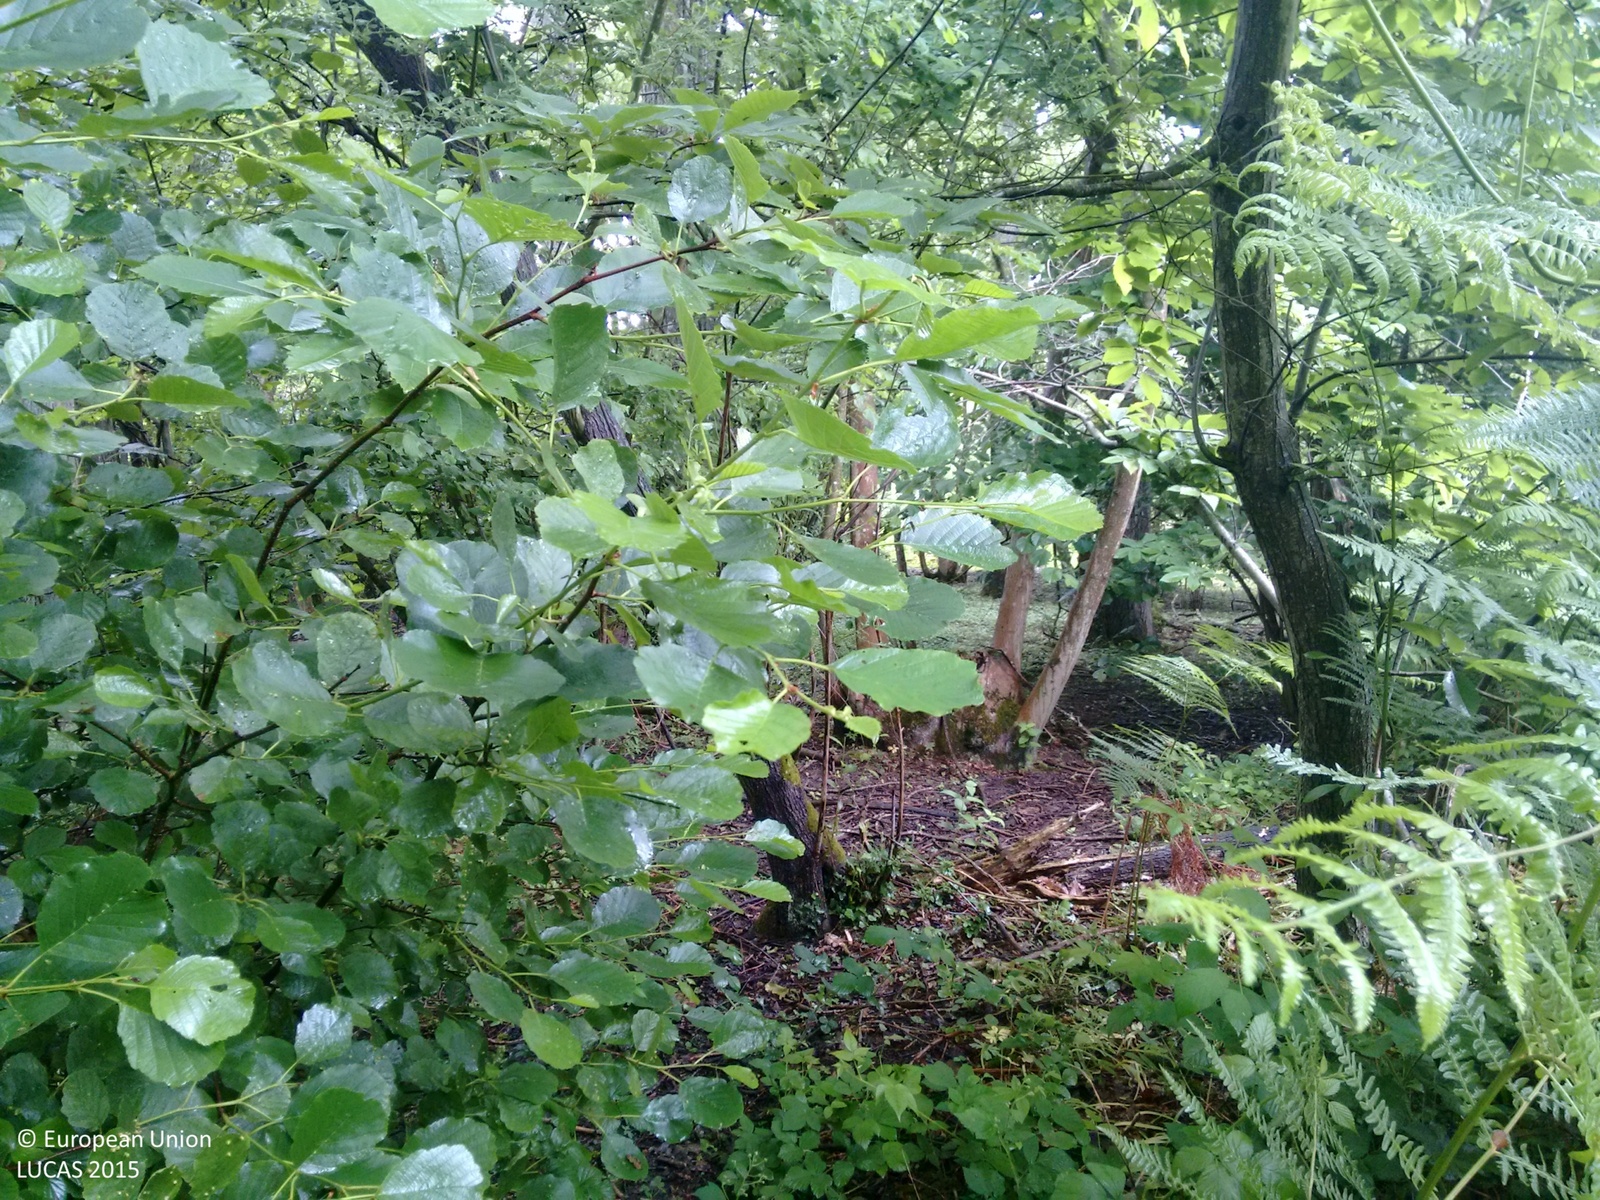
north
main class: Woodland
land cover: Broadleaved woodland
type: mesophytic deciduous forest
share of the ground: > 75 %
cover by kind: broadleaved forest trees 70 %, shrubs 30 %
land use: Forestry
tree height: > 5 m
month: June
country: GB
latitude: 50.8858
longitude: 0.4335
